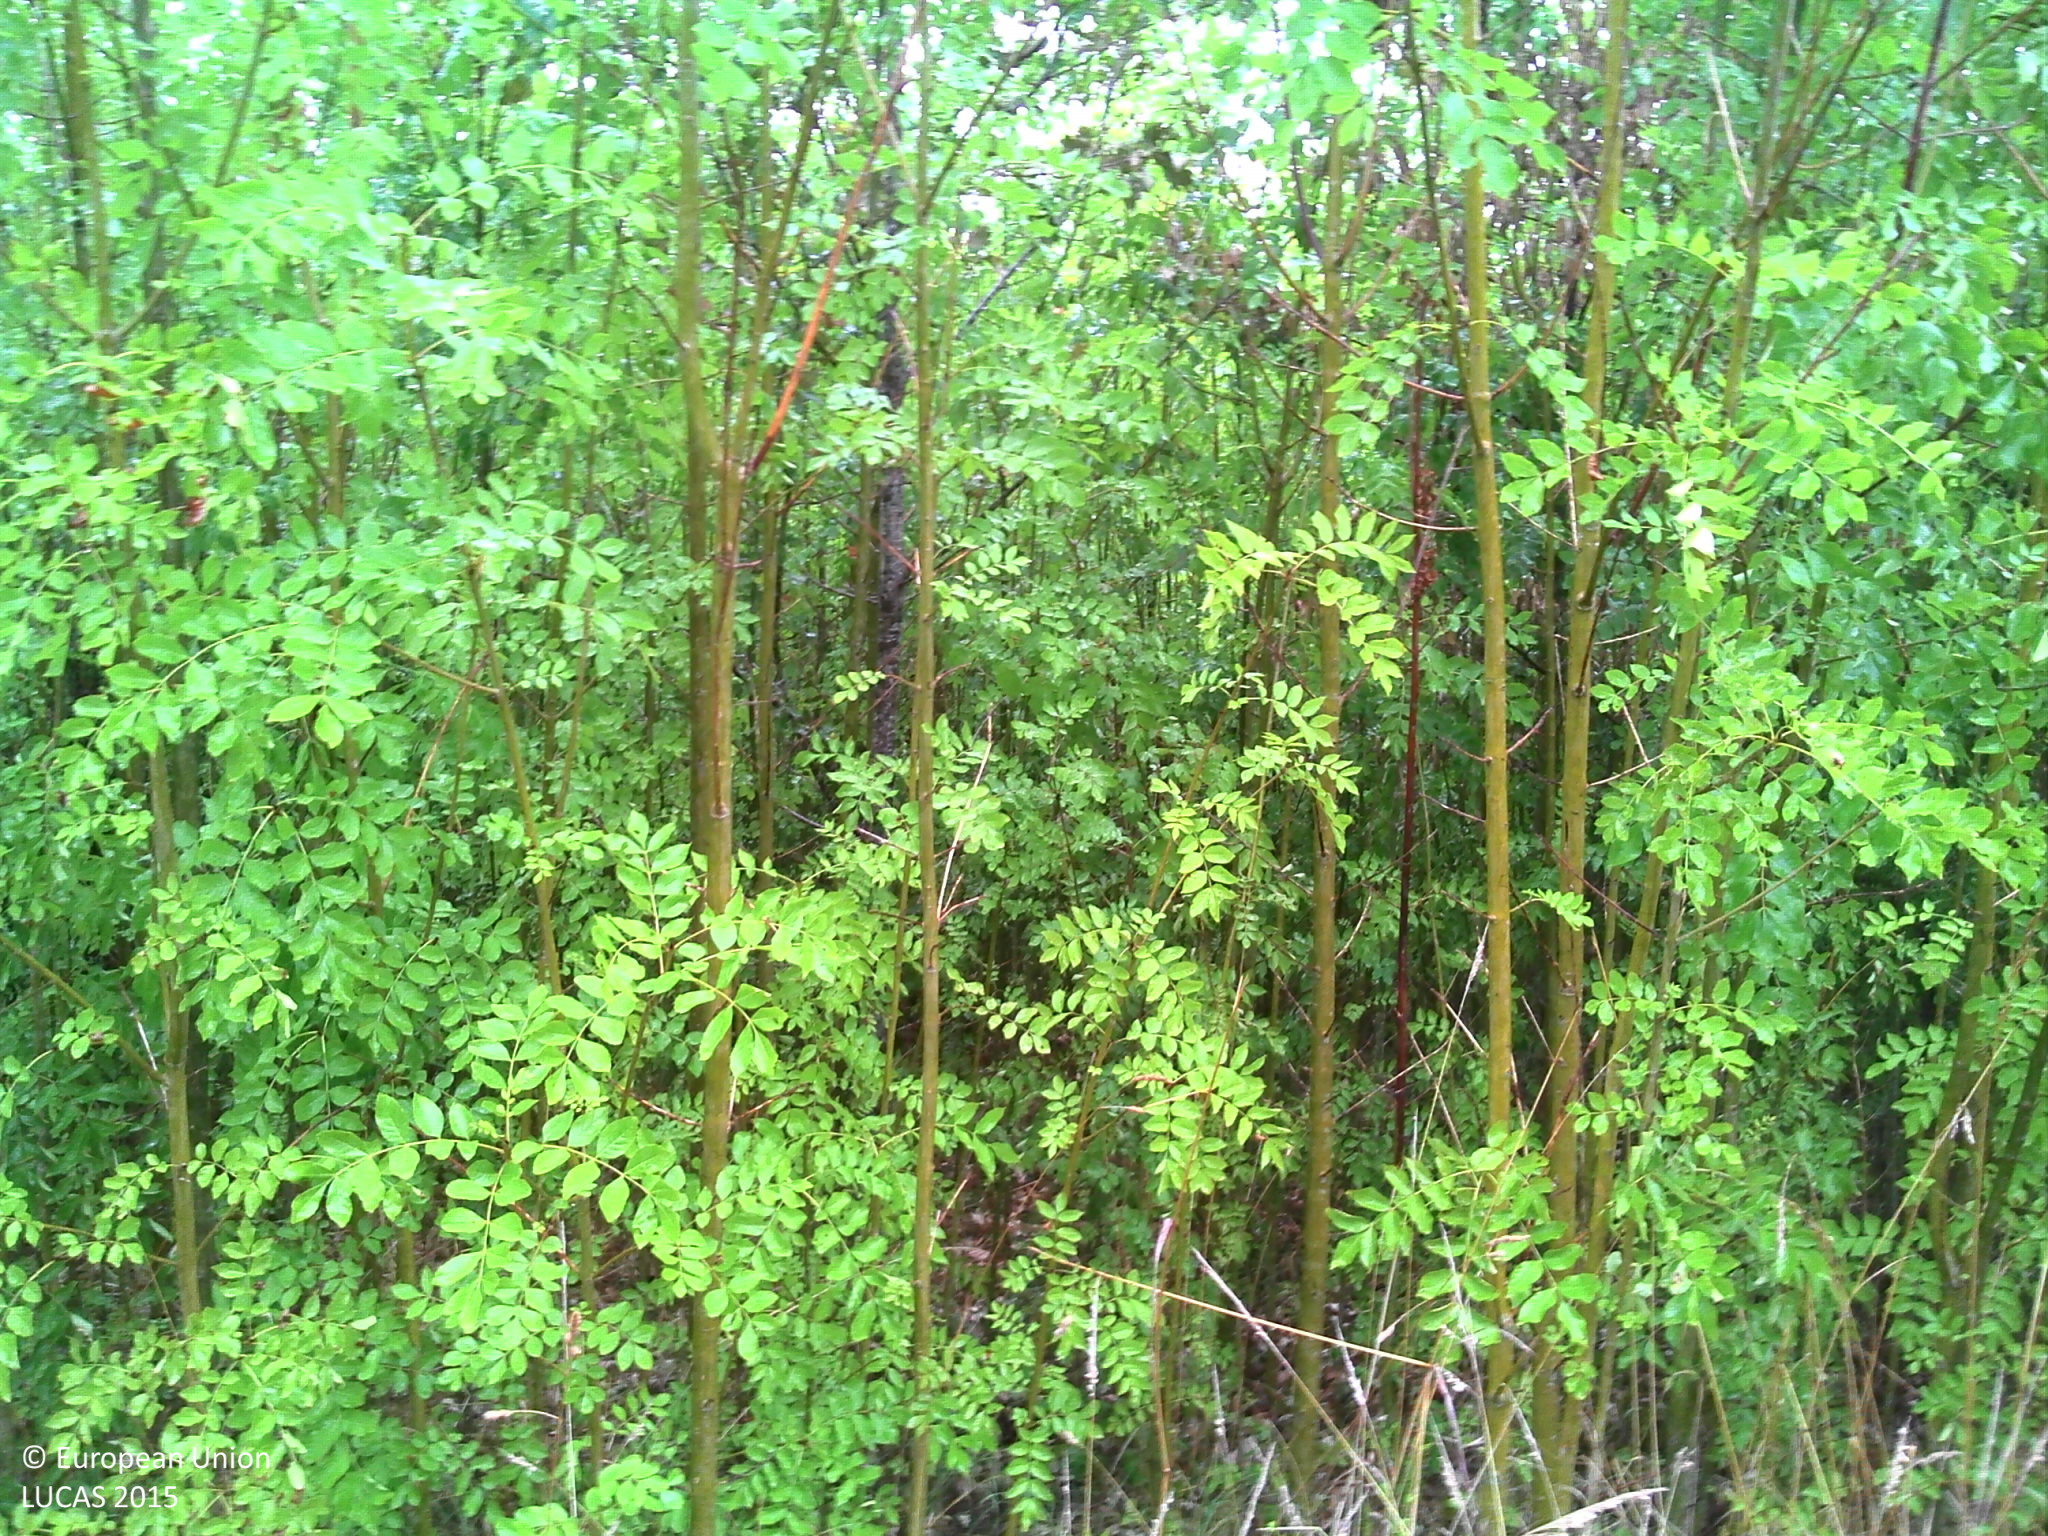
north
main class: Woodland
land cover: Broadleaved woodland
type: mesophytic deciduous forest
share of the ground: > 75 %
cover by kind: broadleaved forest trees 100 %
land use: Forestry
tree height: > 5 m
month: July
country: FR
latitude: 47.8429
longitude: 2.0110
